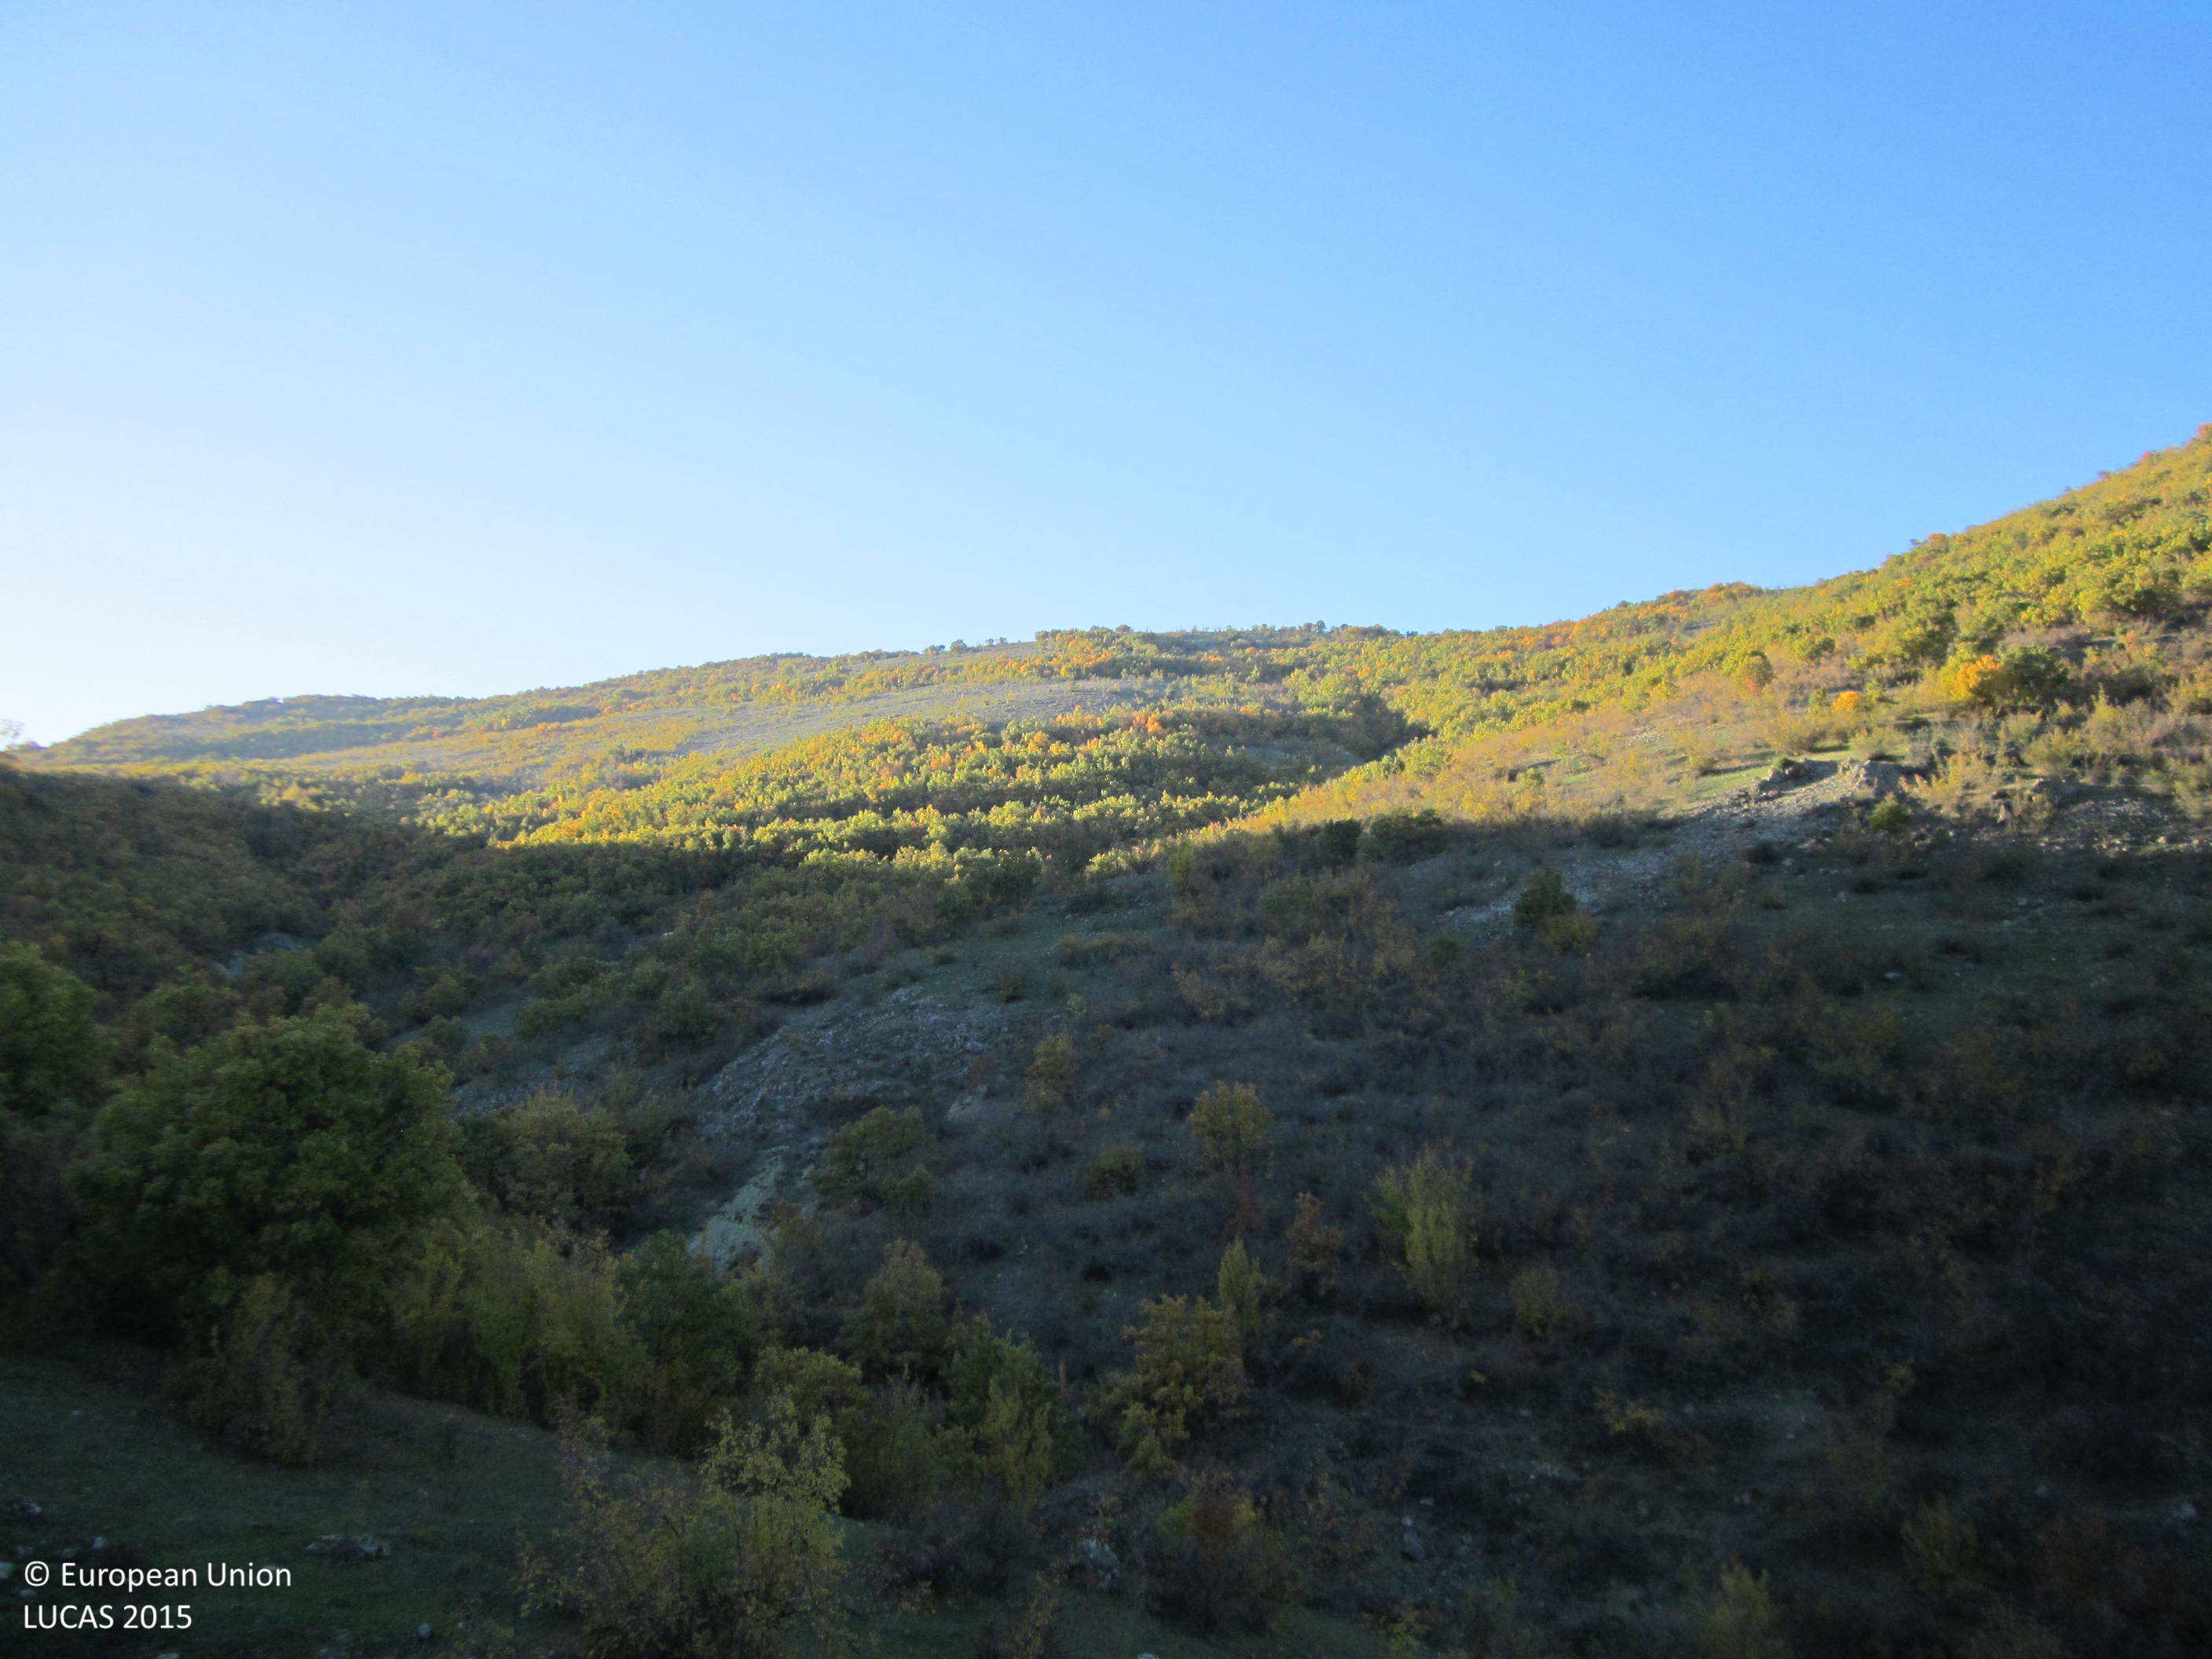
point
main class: Shrubland
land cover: Shrubland with sparse tree cover
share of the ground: 25 - 50 %
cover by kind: herbaceous plants 45 %, shrubs 40 %, unconsolidated bare surface 10 %, broadleaved forest trees 5 %
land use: Agriculture (excluding fallow land and kitchen gardens)
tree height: < 5 m
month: November
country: BG
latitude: 41.5770
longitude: 25.6412
